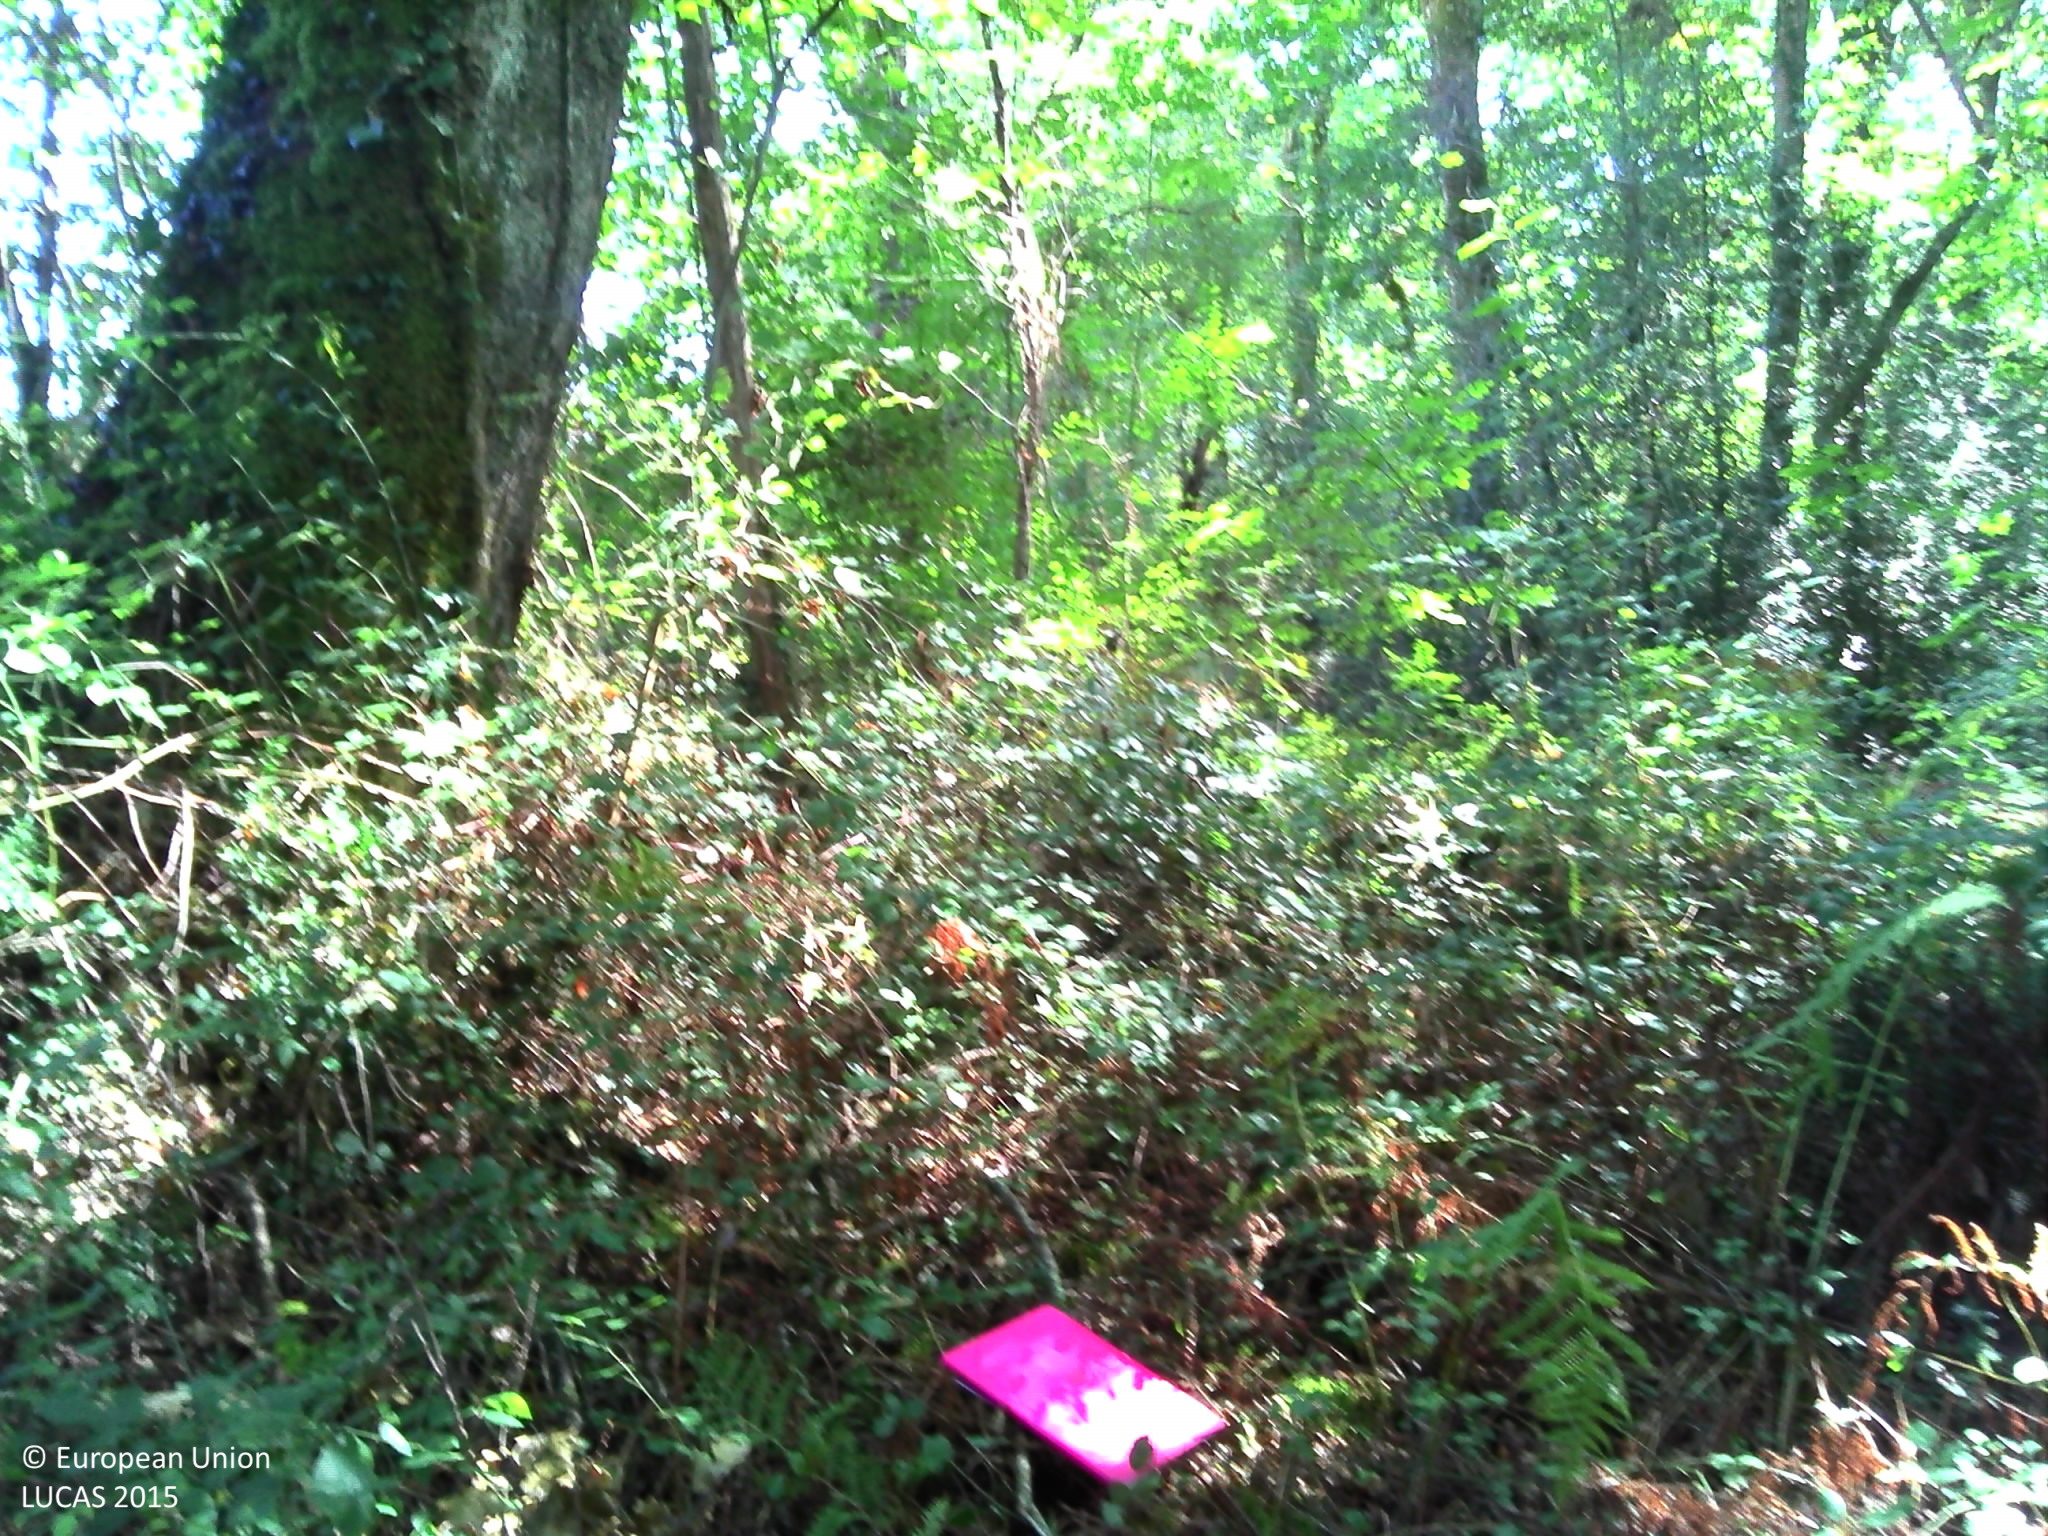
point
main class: Woodland
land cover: Broadleaved woodland
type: acidophilous oak and oak-birch forest
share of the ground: > 75 %
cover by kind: broadleaved forest trees 75 %, shrubs 15 %, herbaceous plants 5 %, lichens and mosses 5 %
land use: Forestry
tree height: > 5 m
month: September
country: FR
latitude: 43.2871
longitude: -0.6945
